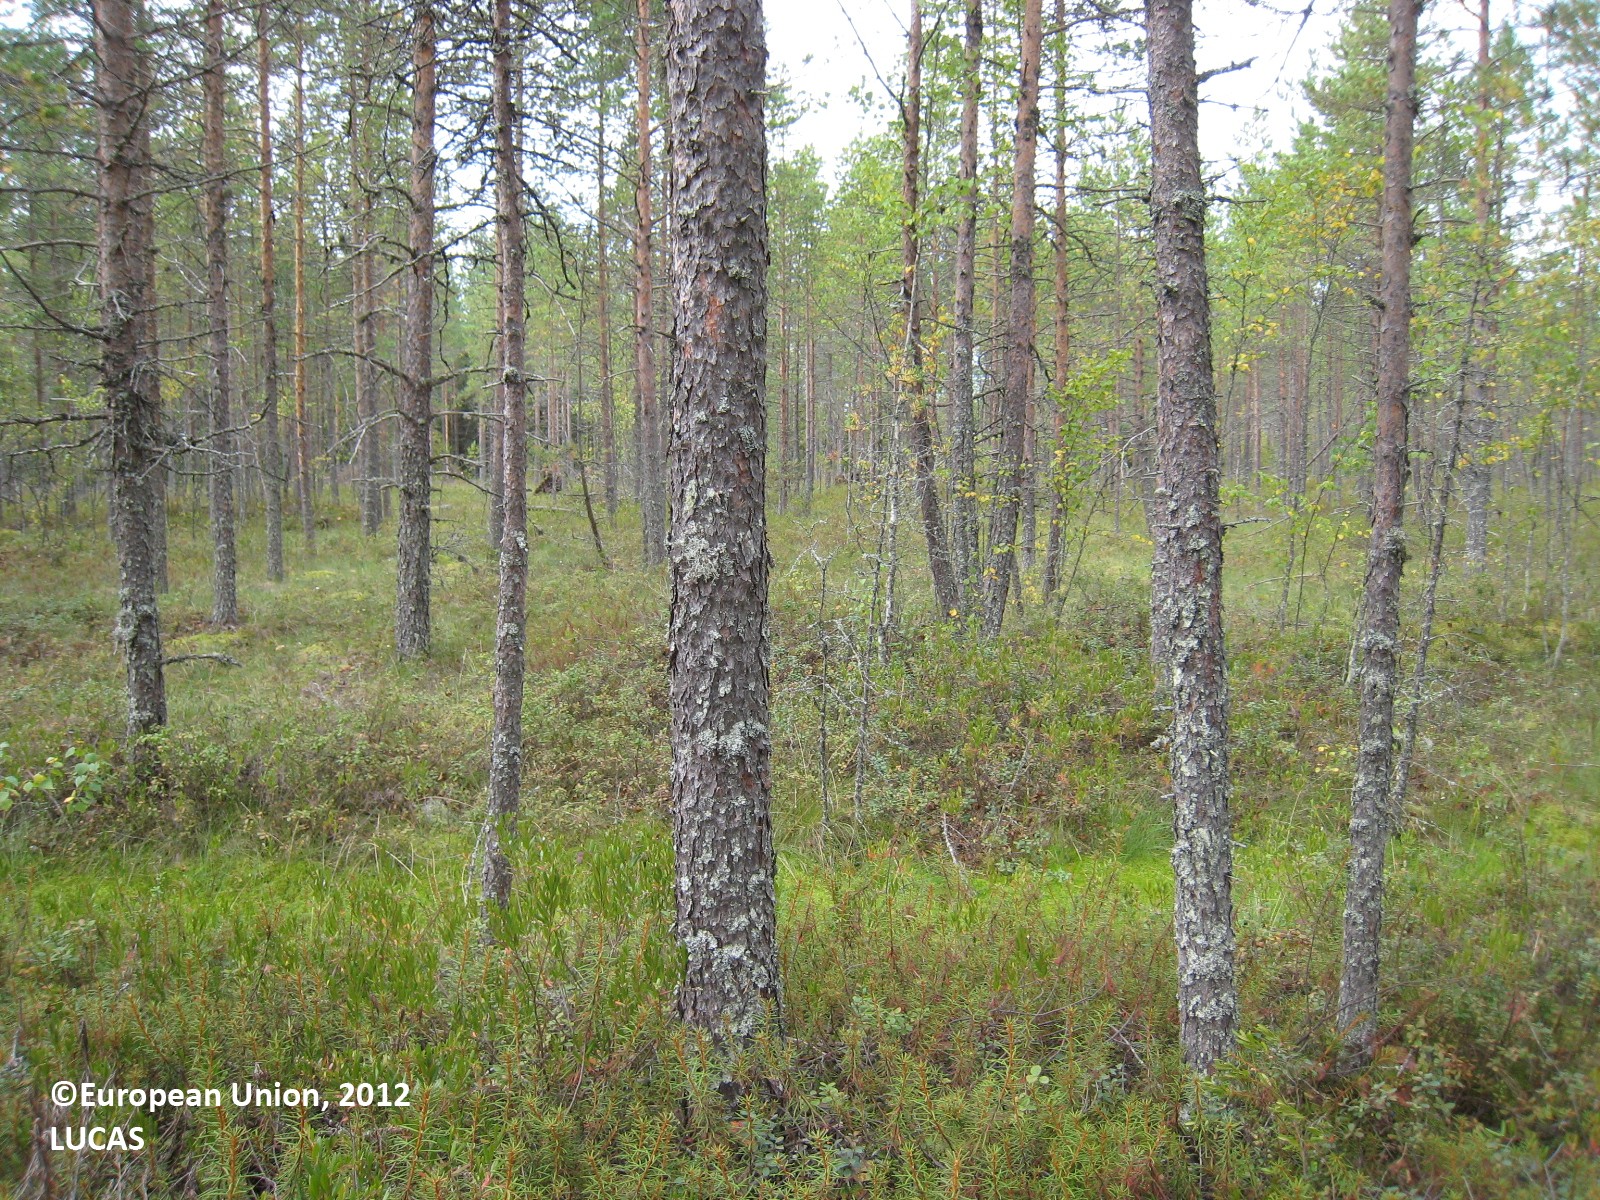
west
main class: Woodland
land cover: Pine dominated coniferous woodland
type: mire and swamp forests
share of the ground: 50 - 75 %
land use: Forestry
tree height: > 5 m
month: August
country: FI
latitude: 62.3633
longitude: 27.2632
